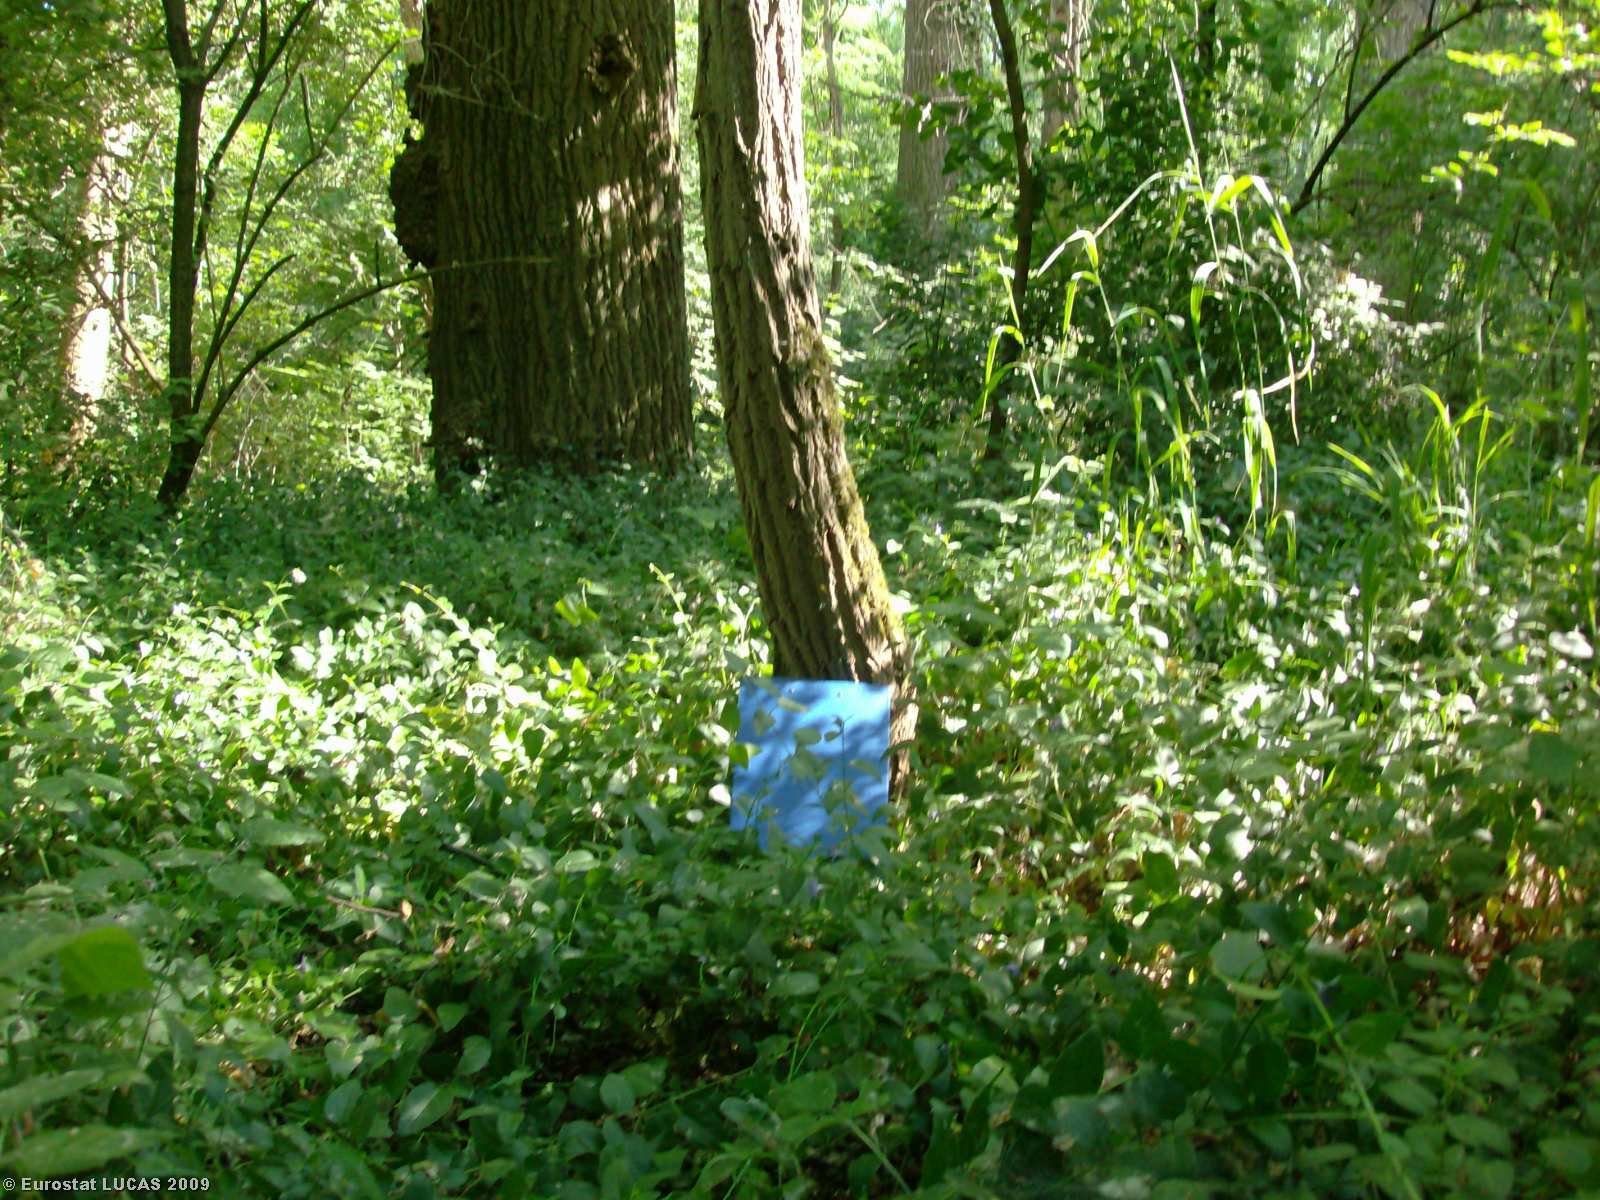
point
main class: Woodland
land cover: Broadleaved woodland
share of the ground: > 75 %
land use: Nature reserves
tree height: > 5 m
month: June
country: IT
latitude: 45.5574
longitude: 9.5268
